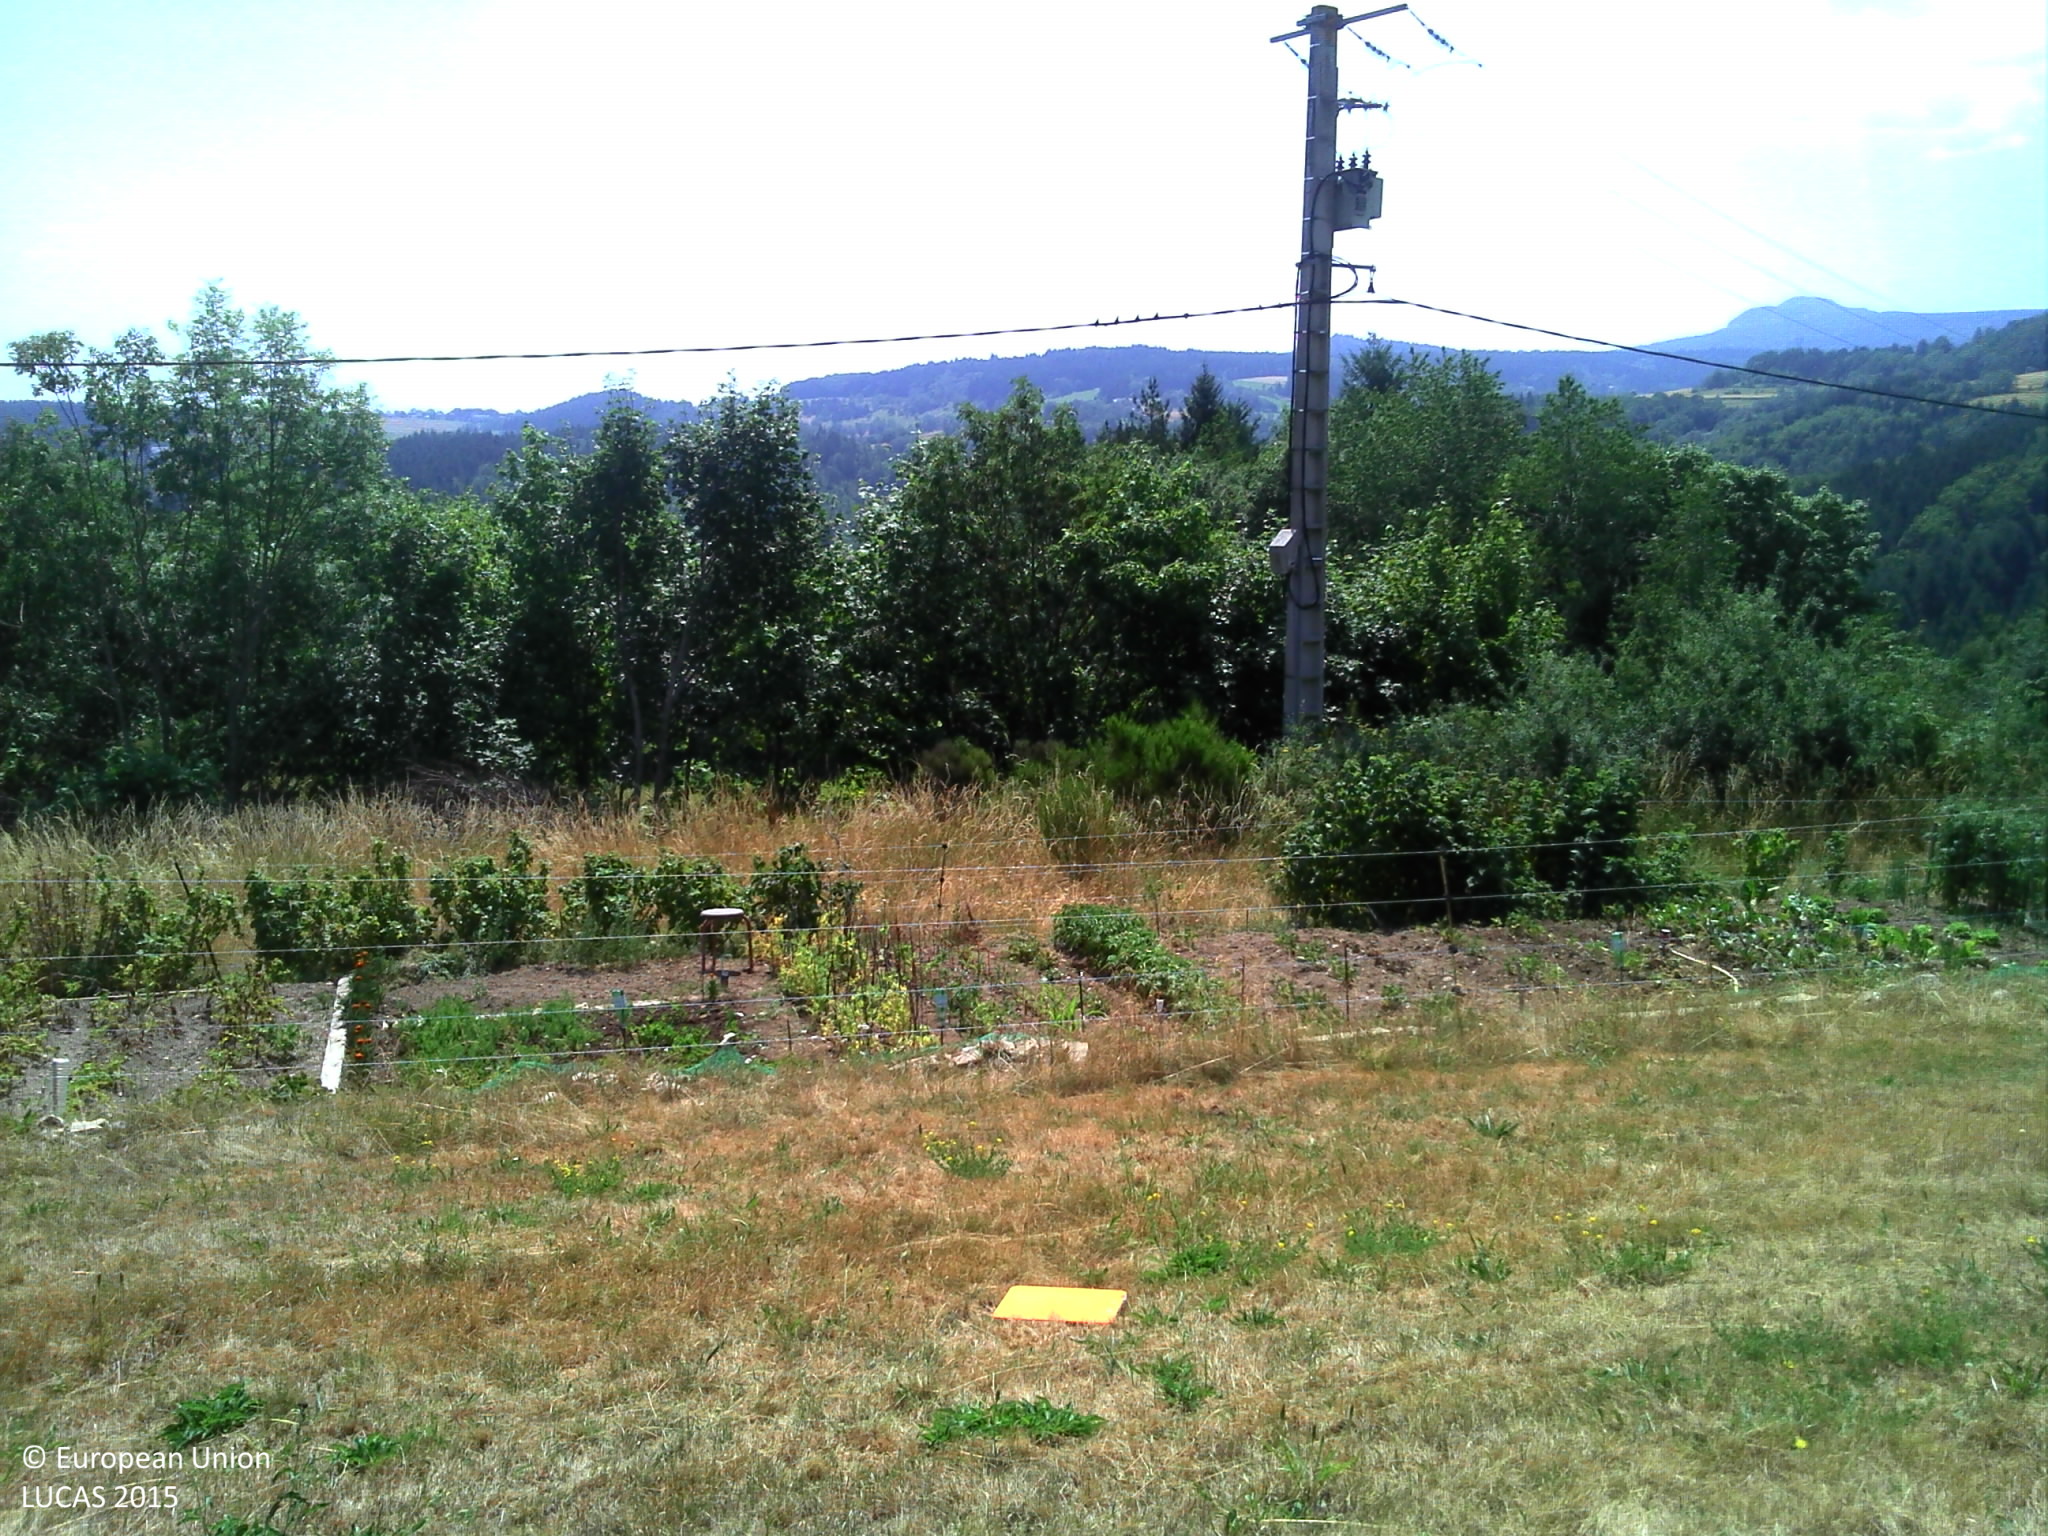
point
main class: Grassland
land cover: Grassland without tree/shrub cover
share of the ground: > 75 %
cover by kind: herbaceous plants 100 %
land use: Agriculture (excluding fallow land and kitchen gardens)
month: July
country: FR
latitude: 45.1085
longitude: 4.1706
